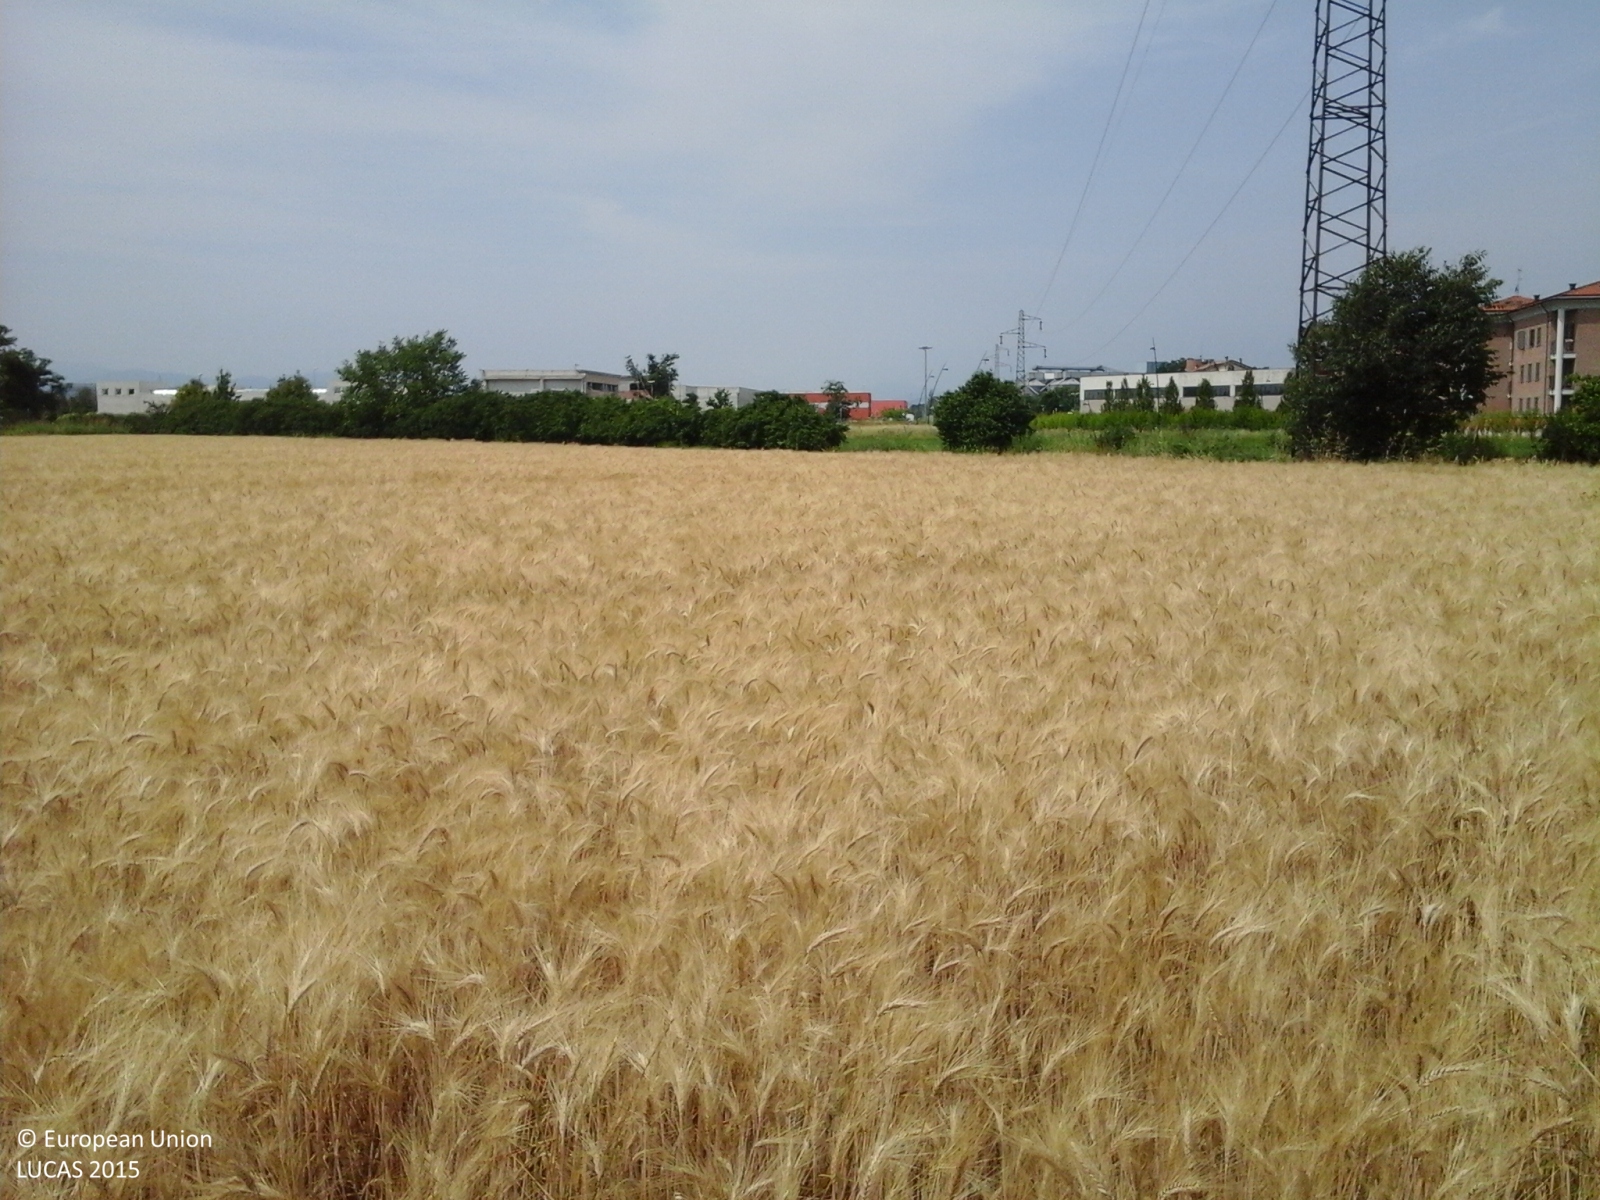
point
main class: Cropland
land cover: Common wheat
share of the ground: > 75 %
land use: Agriculture (excluding fallow land and kitchen gardens)
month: June
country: IT
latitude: 44.7830
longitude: 10.2648
